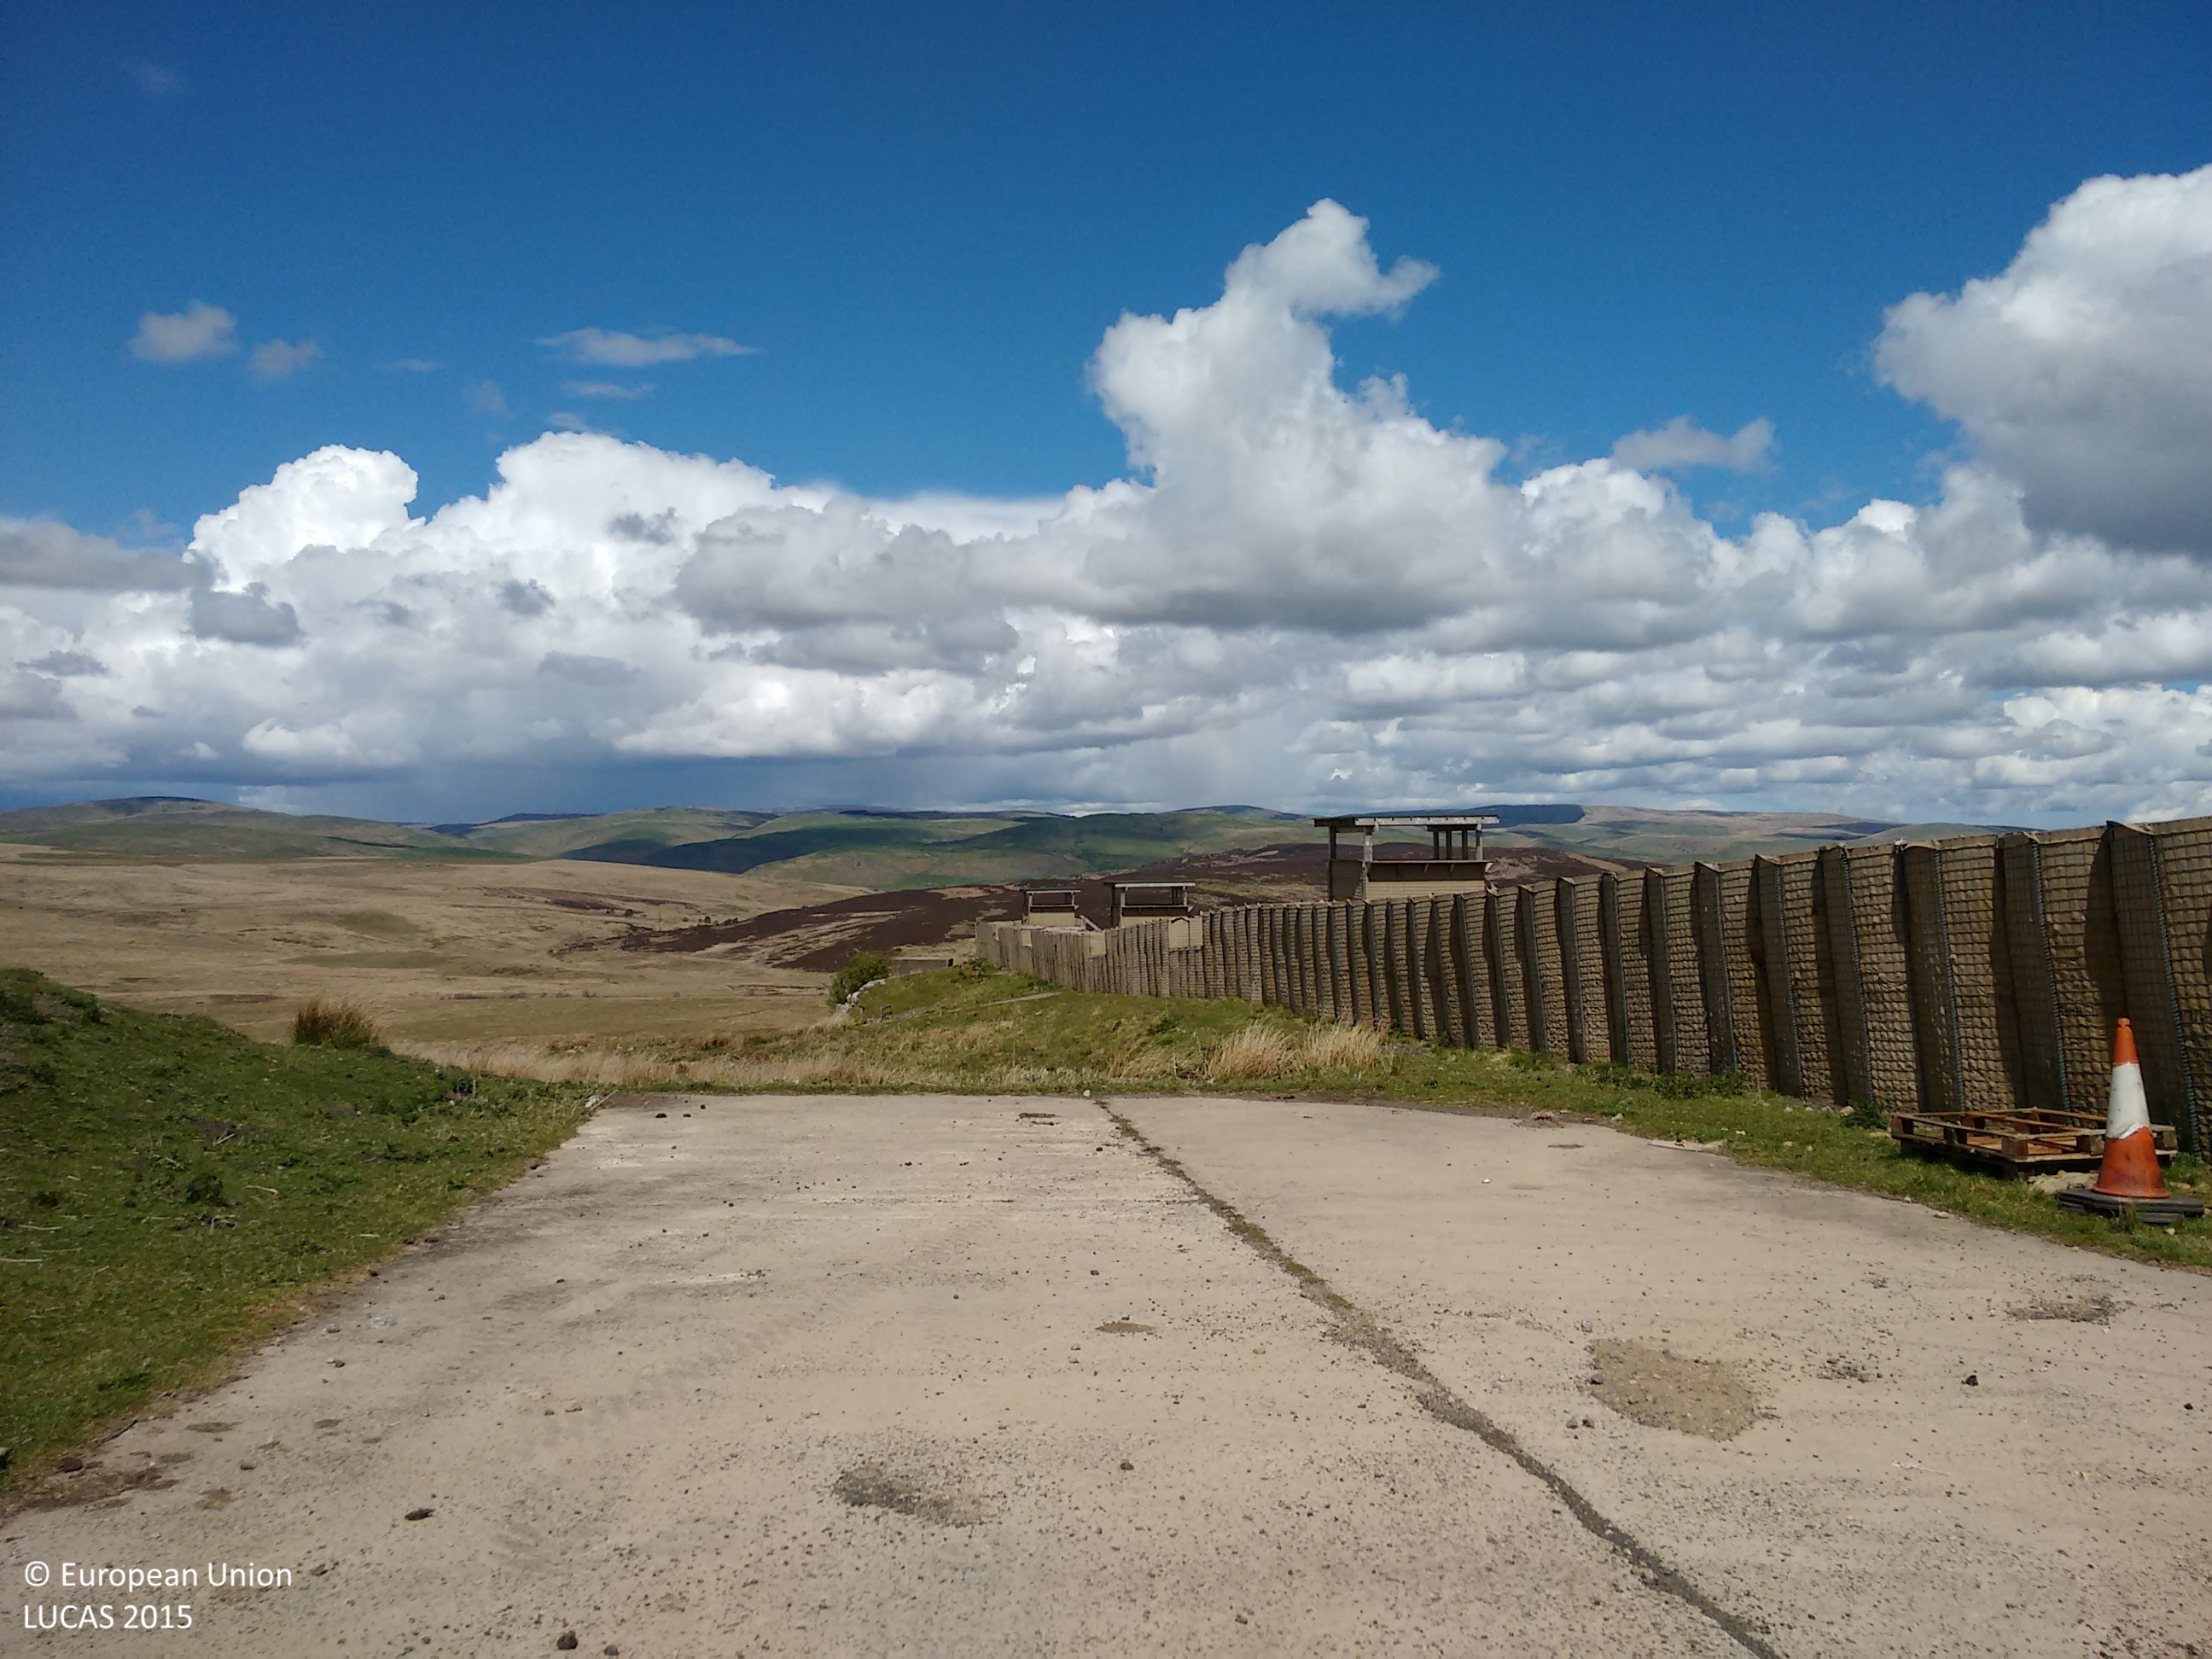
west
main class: Shrubland
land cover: Shrubland without tree cover
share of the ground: > 75 %
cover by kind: shrubs 80 %, herbaceous plants 20 %
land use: Agriculture (excluding fallow land and kitchen gardens)
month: May
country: GB
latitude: 55.3143
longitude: -2.1731
